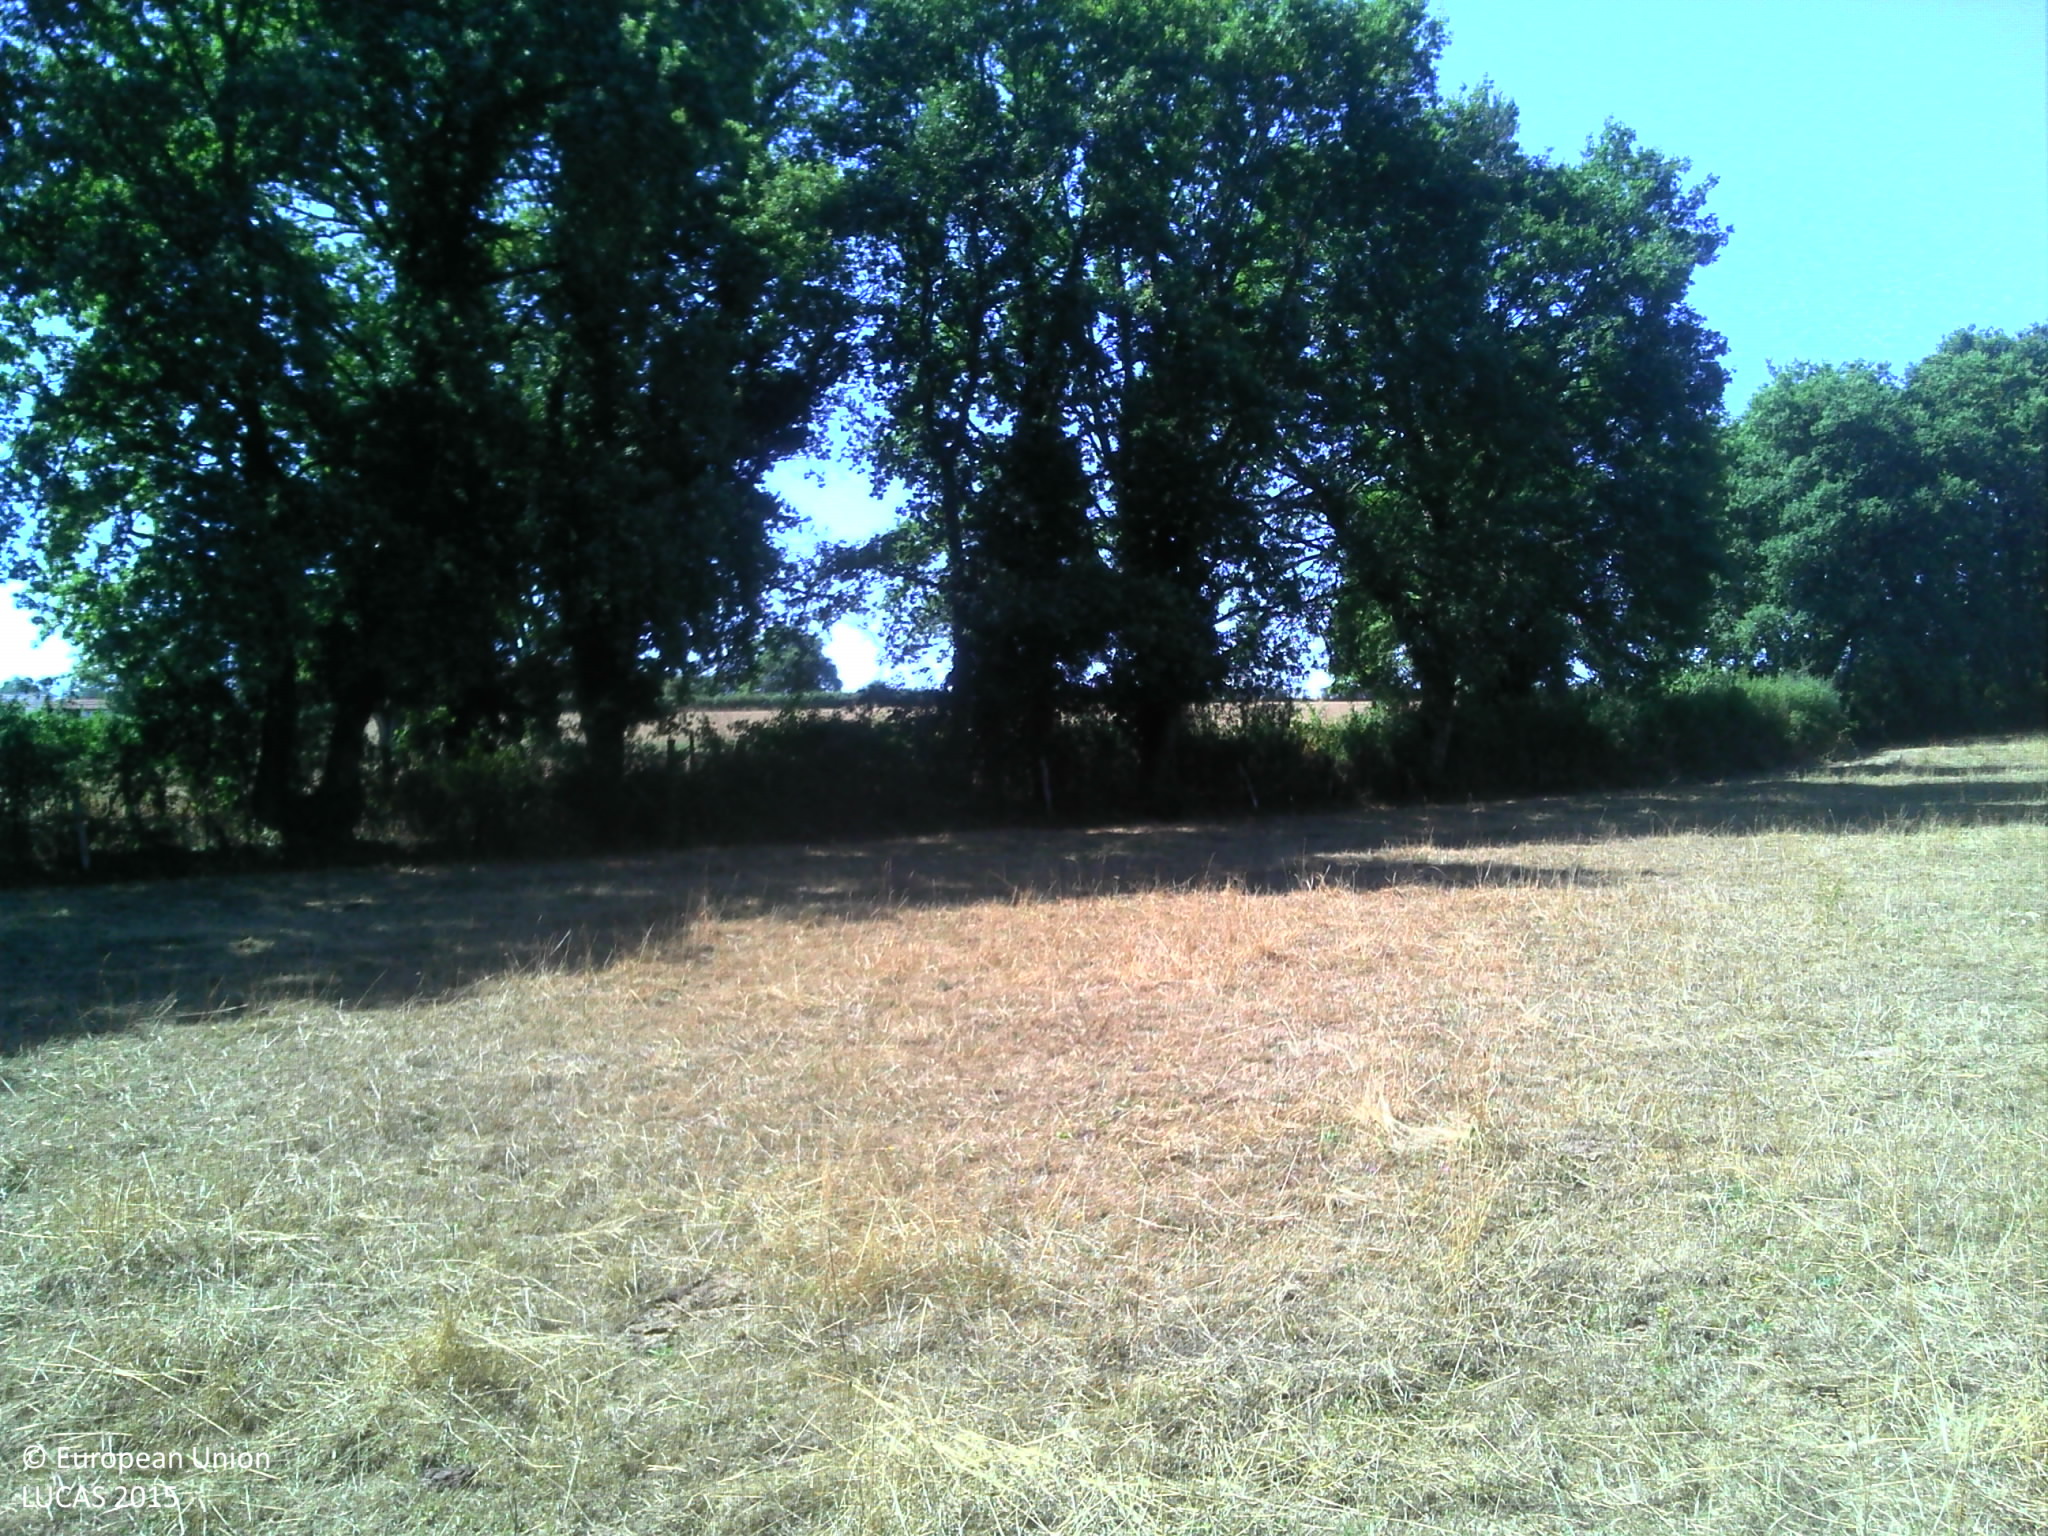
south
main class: Grassland
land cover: Grassland without tree/shrub cover
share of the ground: > 75 %
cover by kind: herbaceous plants 100 %
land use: Agriculture (excluding fallow land and kitchen gardens)
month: August
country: FR
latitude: 46.6555
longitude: 4.3948
